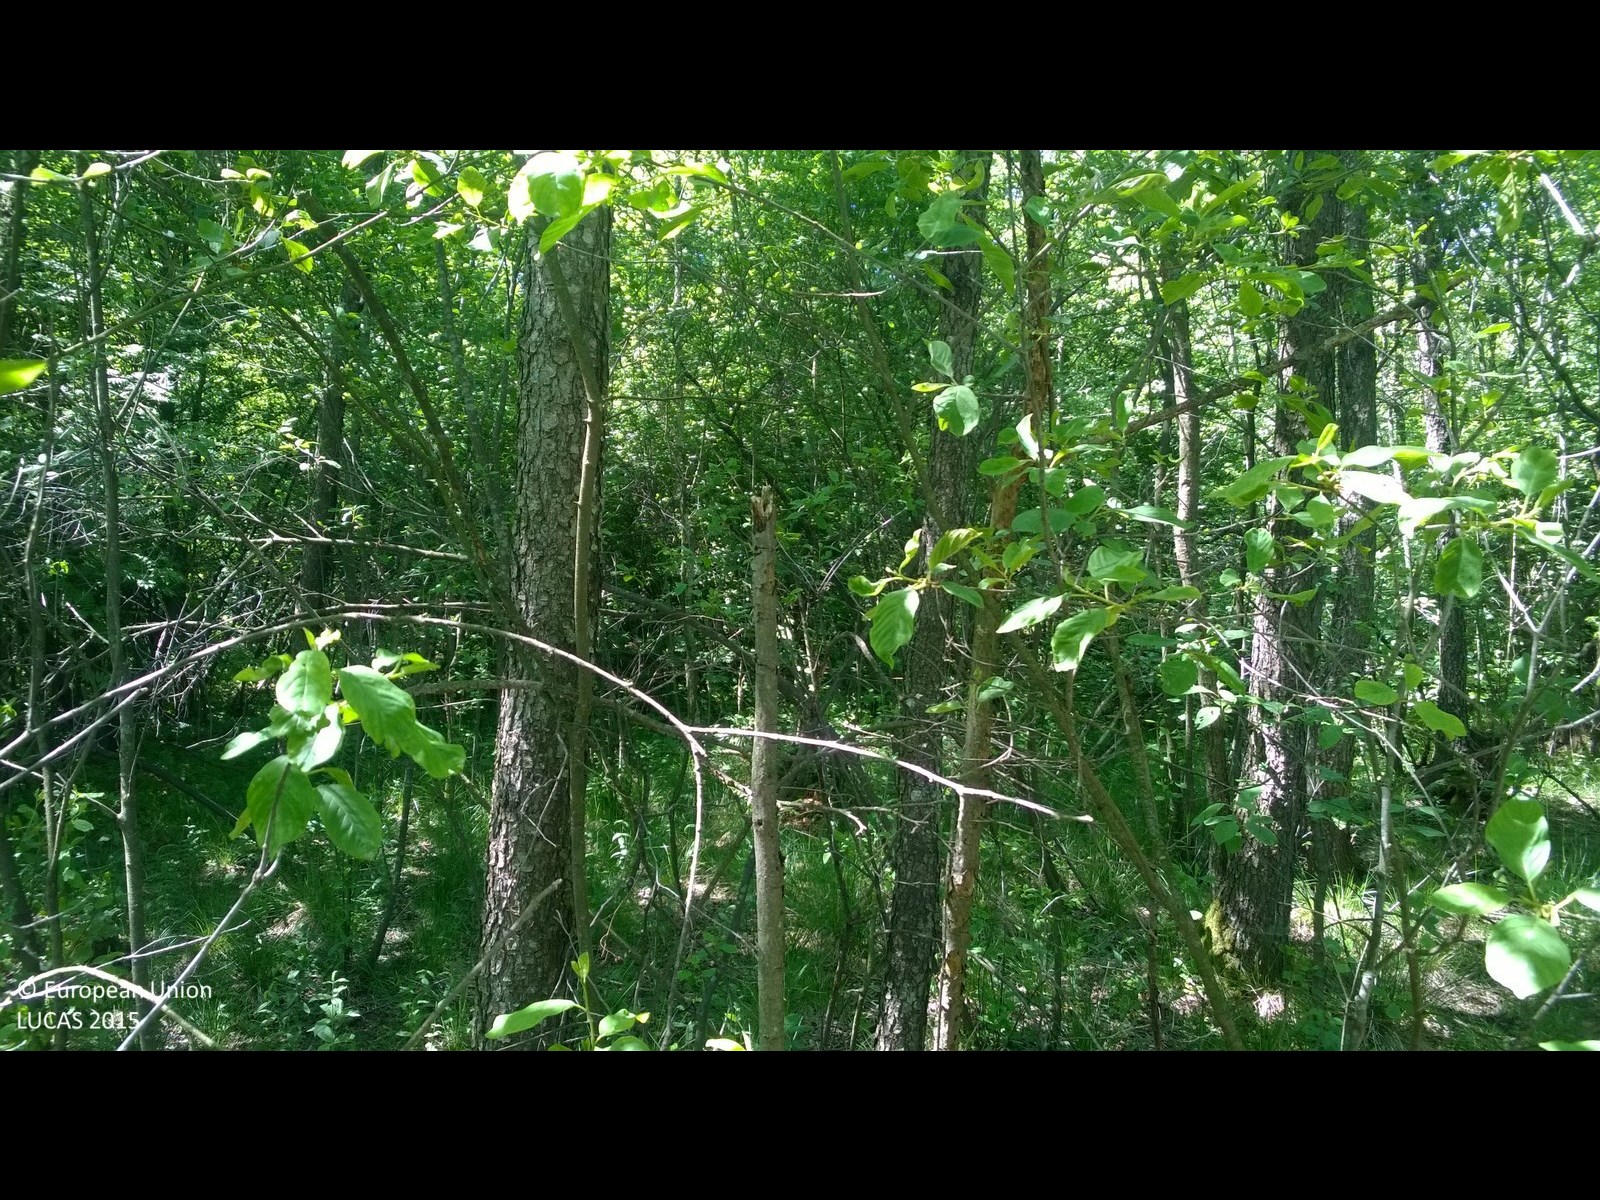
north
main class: Woodland
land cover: Broadleaved woodland
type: mesophytic deciduous forest
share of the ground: > 75 %
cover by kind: broadleaved forest trees 80 %, shrubs 15 %, herbaceous plants 5 %
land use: Forestry
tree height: > 5 m
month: June
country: PL
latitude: 53.0038
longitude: 23.3590
